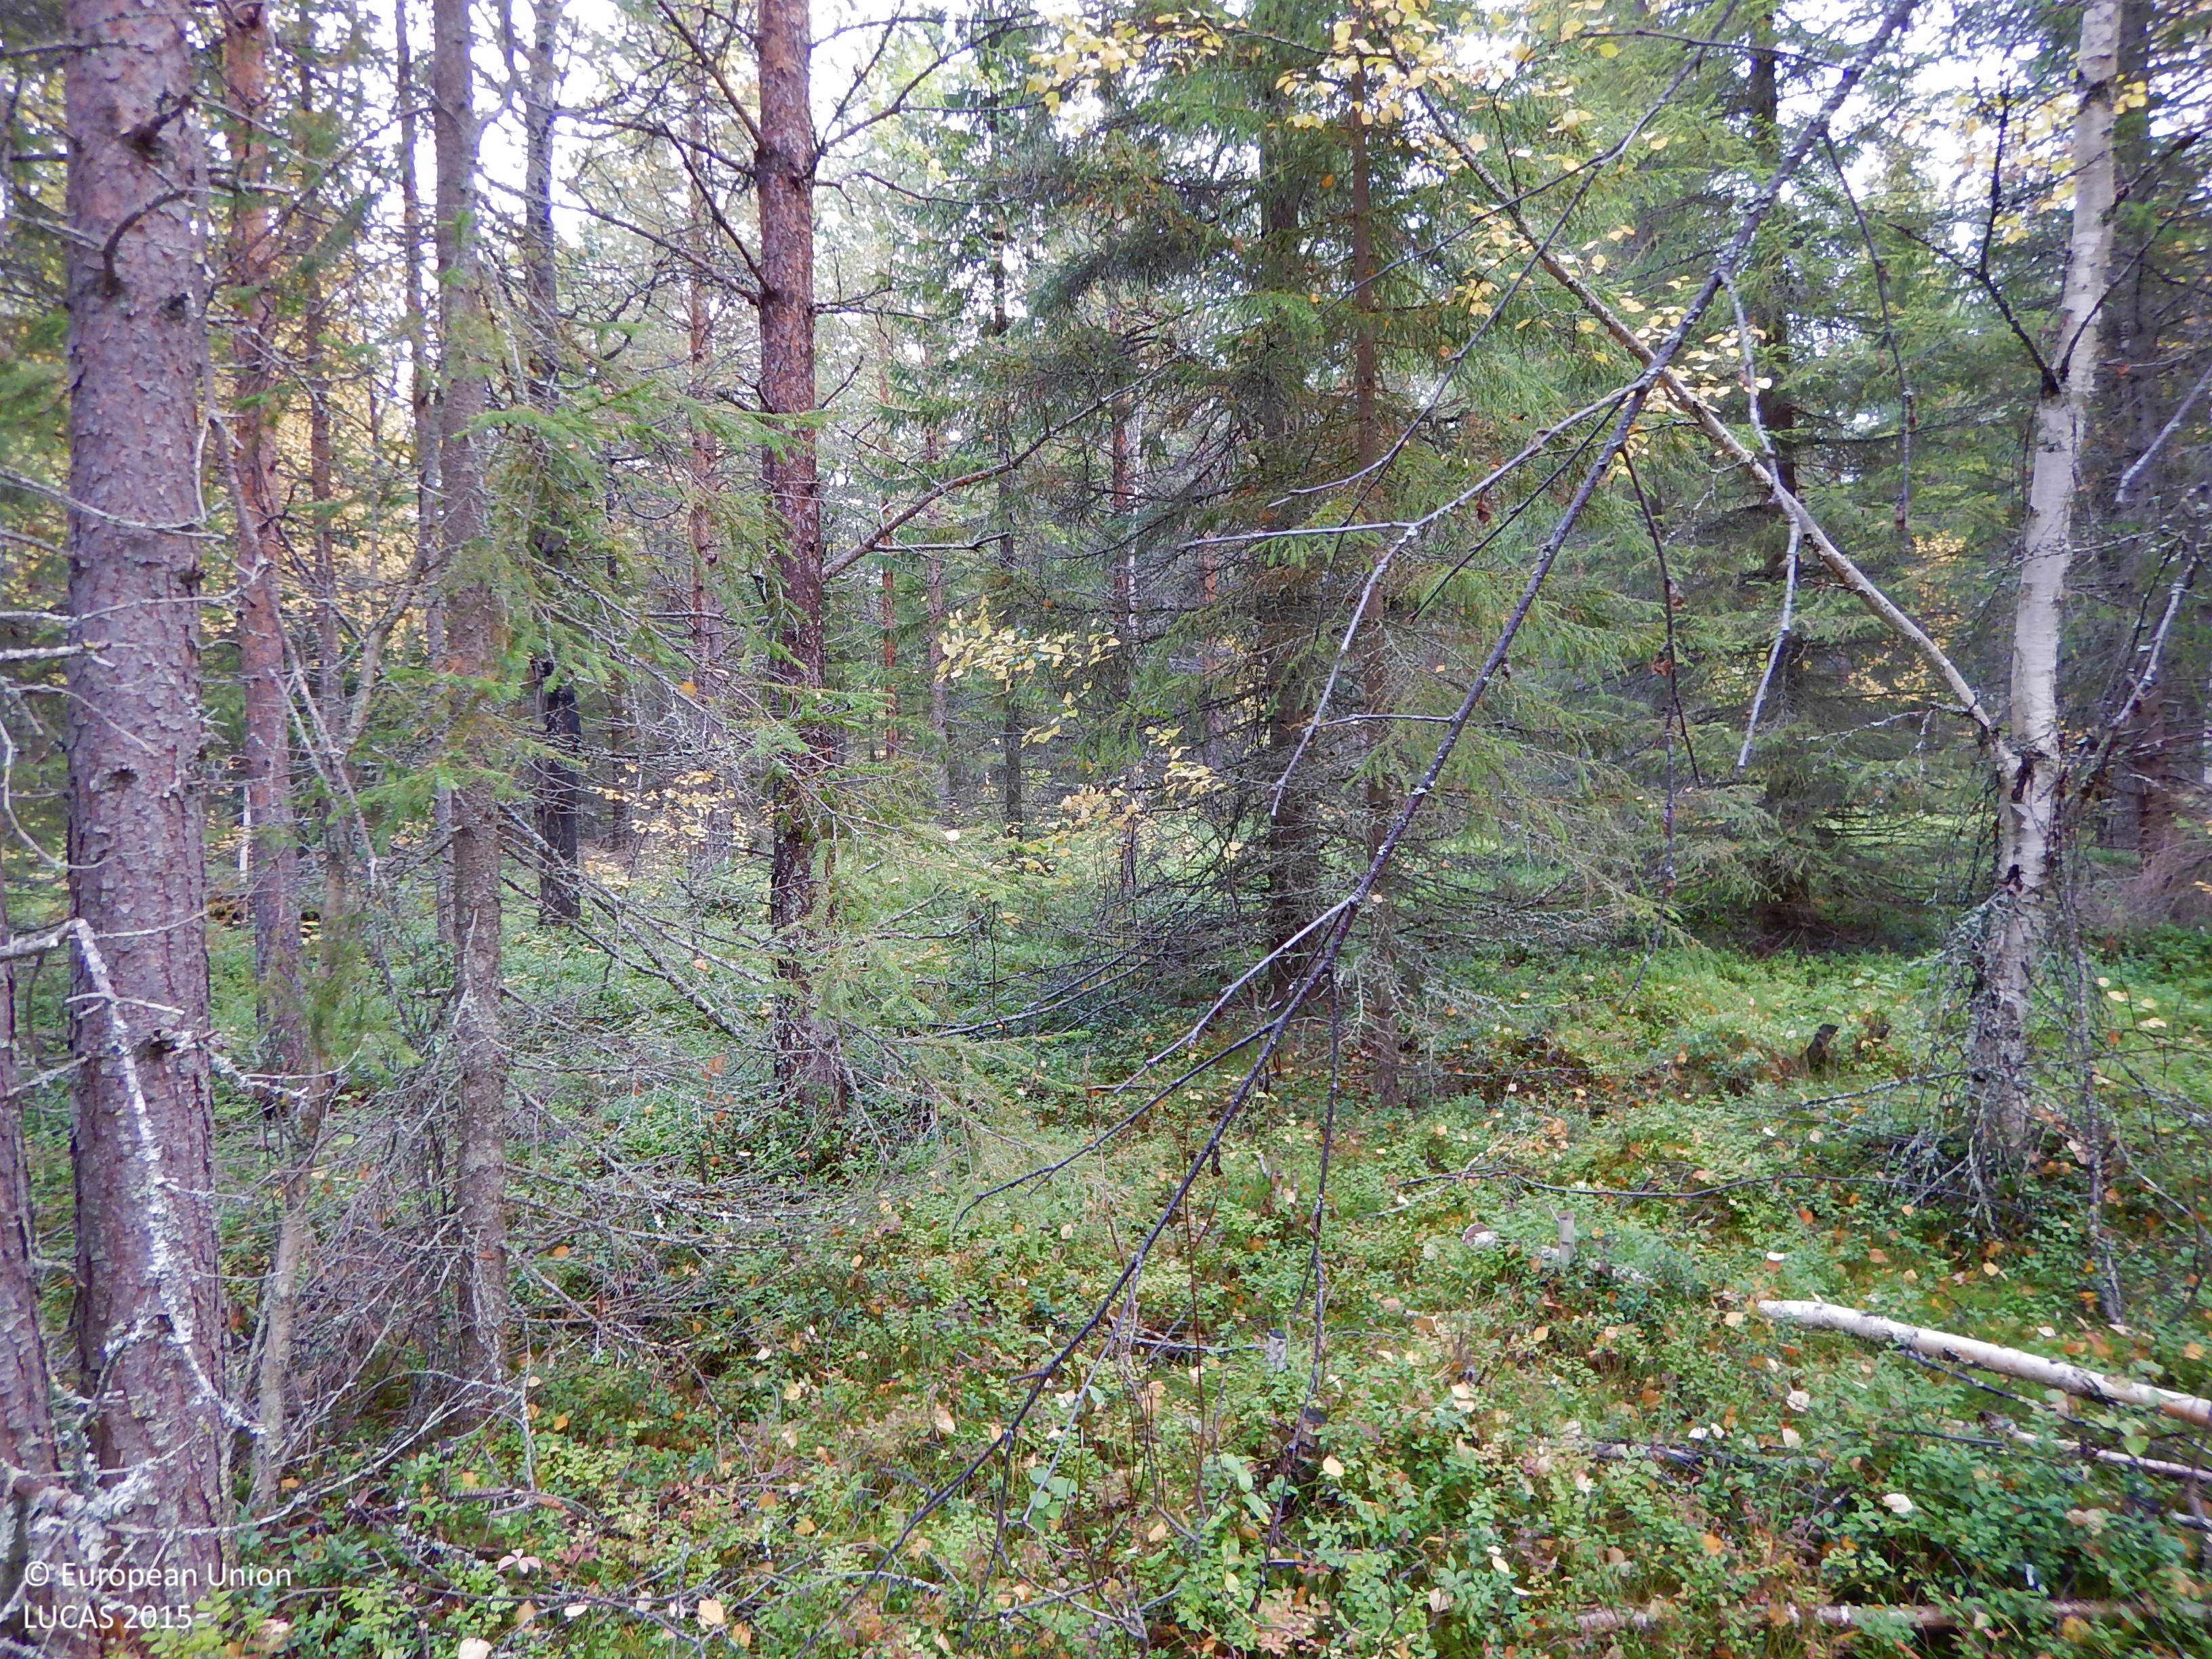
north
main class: Woodland
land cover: Other coniferous woodland
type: boreal forest
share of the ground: 50 - 75 %
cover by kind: coniferous forest trees 60 %, shrubs 15 %, herbaceous plants 10 %, lichens and mosses 10 %, broadleaved forest trees 5 %
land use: Forestry
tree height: > 5 m
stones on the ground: < 10 %
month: September
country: SE
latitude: 64.8001
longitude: 19.8850
